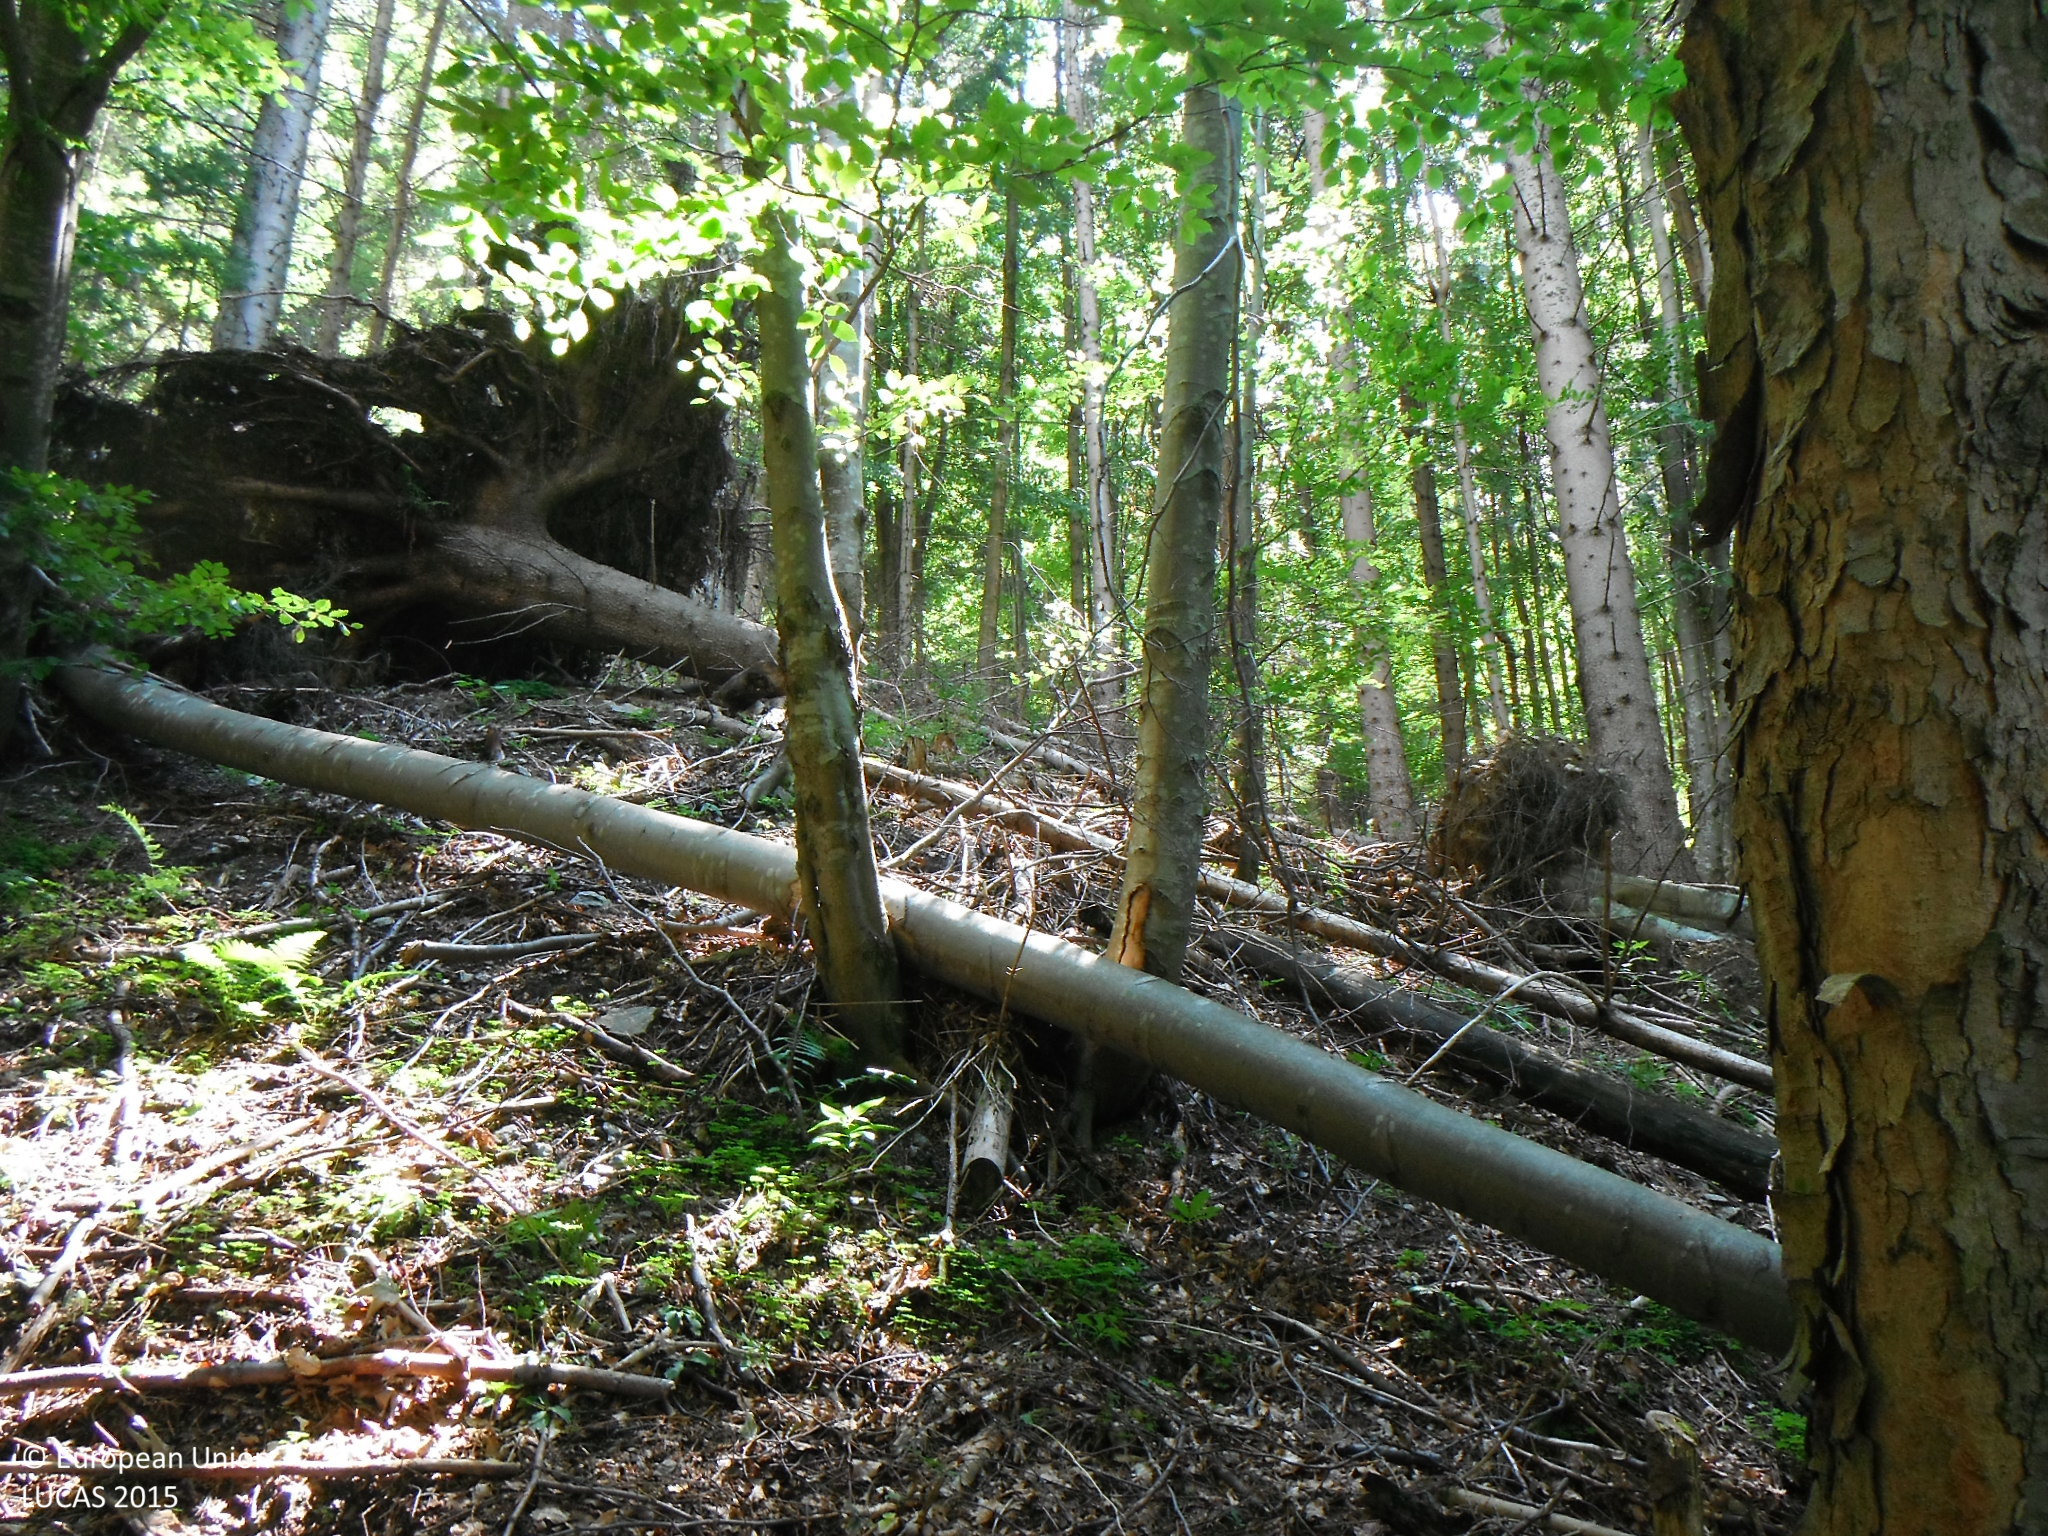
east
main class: Woodland
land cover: Spruce dominated mixed woodland
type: hemiboreal forest and nemoral coniferous forest and mixed broadleaved-coniferous forest
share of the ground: > 75 %
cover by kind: coniferous forest trees 65 %, broadleaved forest trees 25 %, herbaceous plants 10 %
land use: Forestry
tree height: > 5 m
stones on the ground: 25 - 50 %
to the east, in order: Spruce dominated mixed woodland; Tracks; Spruce dominated mixed woodland; Spruce dominated coniferous woodland; Spruce dominated mixed woodland
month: July
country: SK
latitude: 48.8979
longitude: 19.7265
